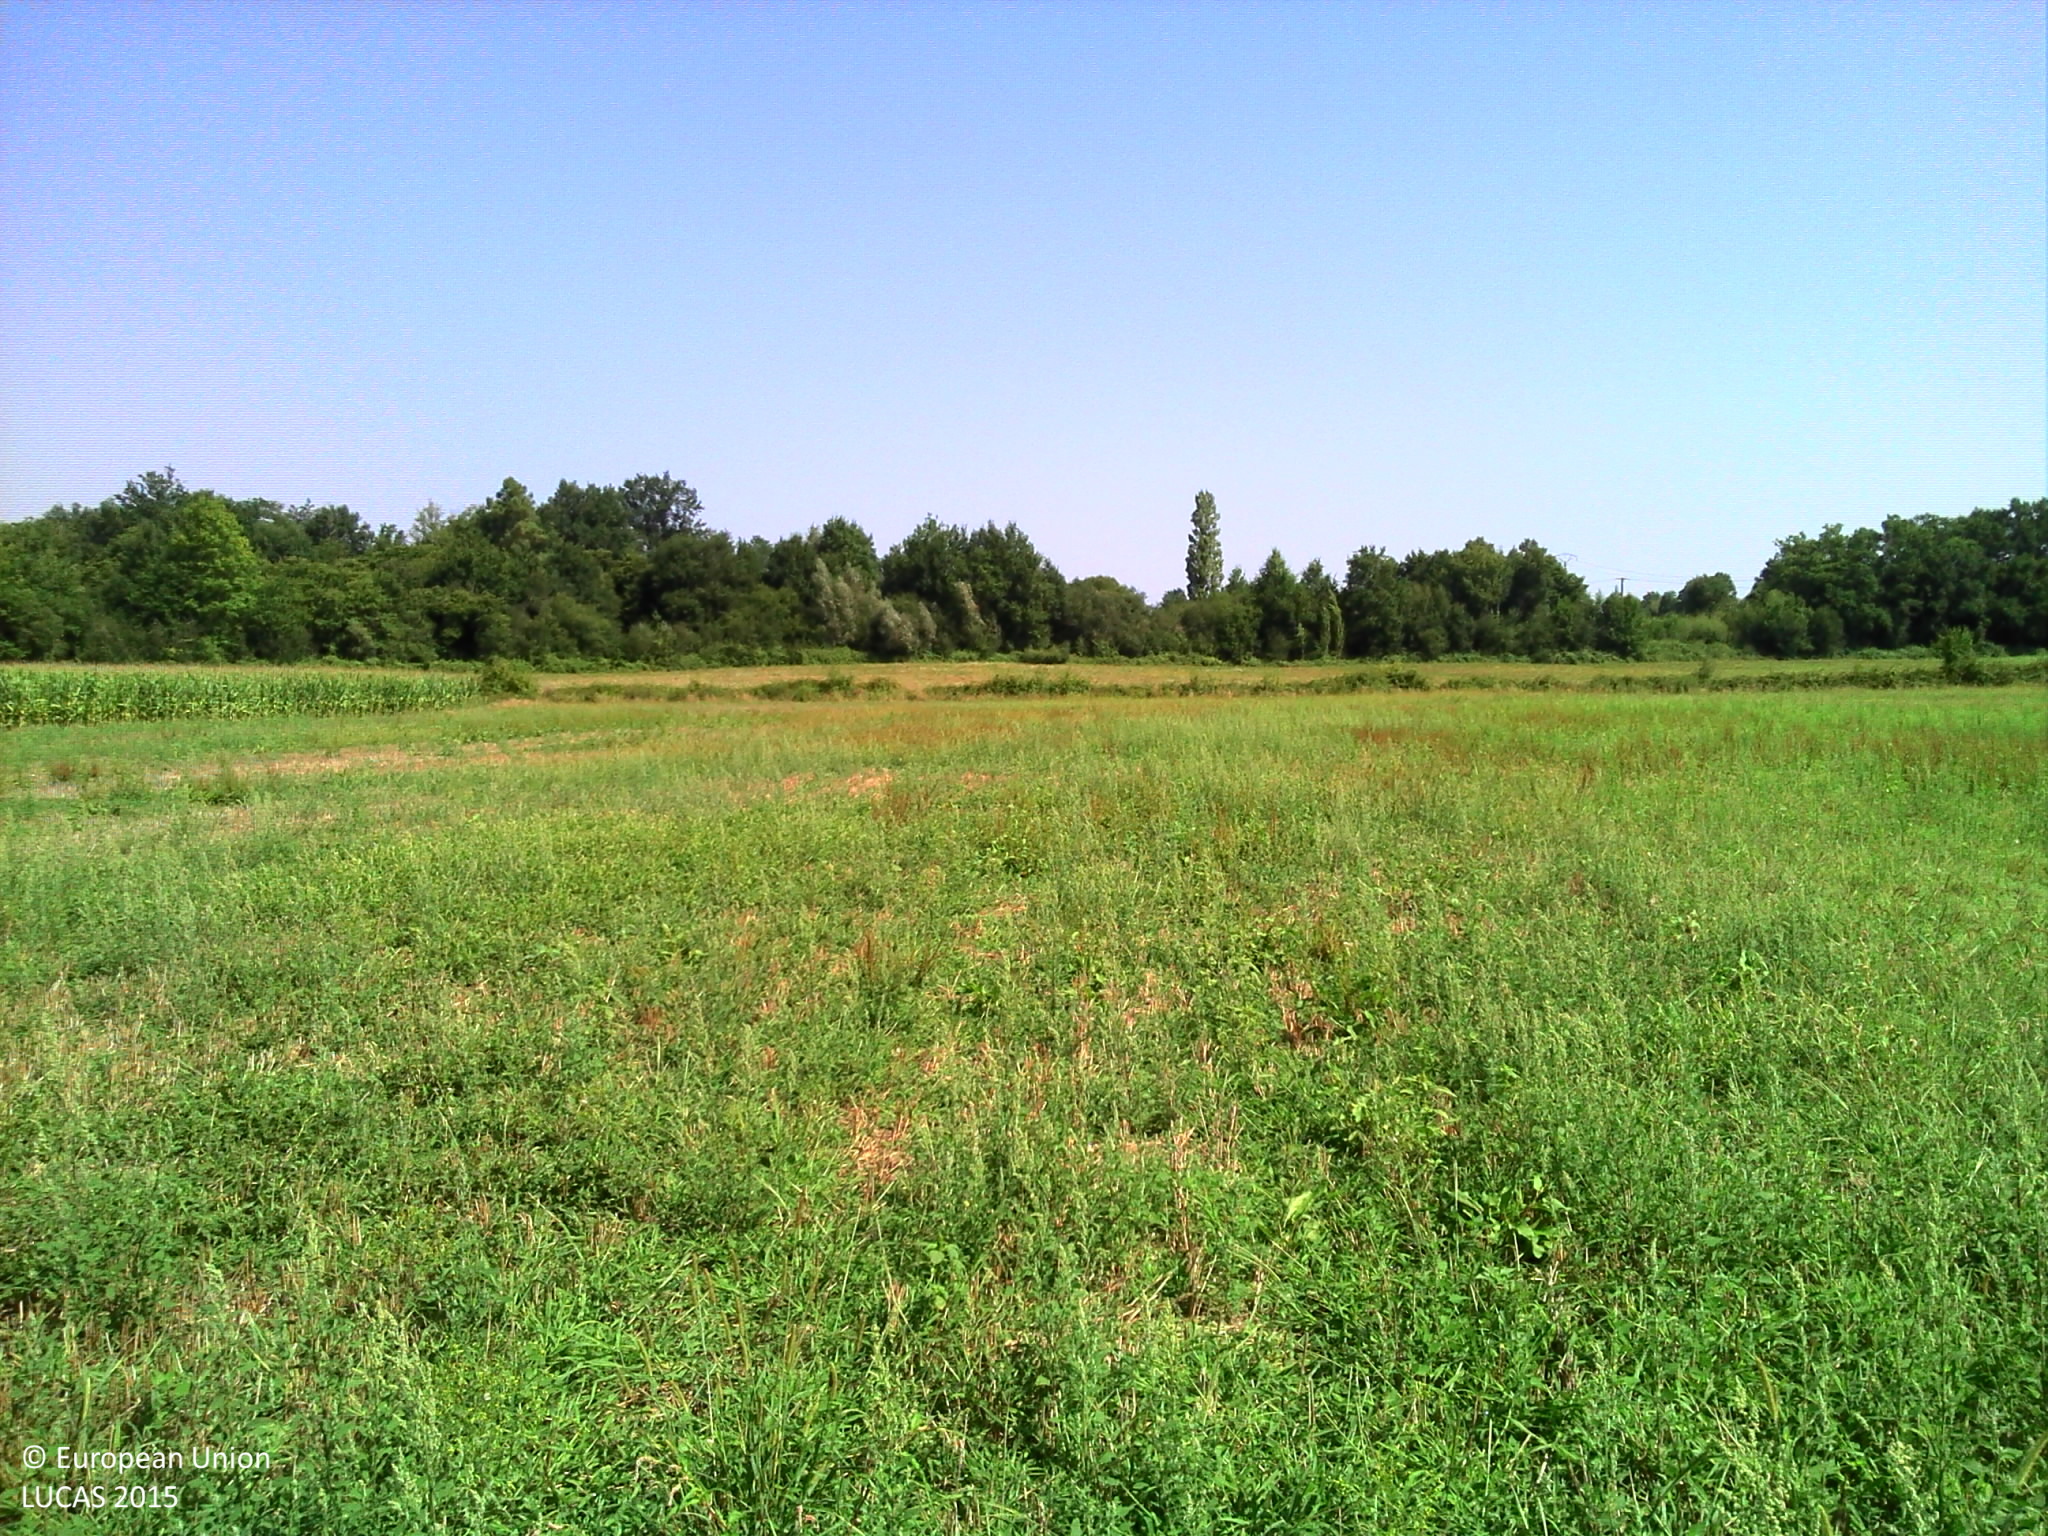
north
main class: Cropland
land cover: Temporary grasslands
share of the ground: > 75 %
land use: Agriculture (excluding fallow land and kitchen gardens)
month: August
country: FR
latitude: 43.7968
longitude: -0.5135
